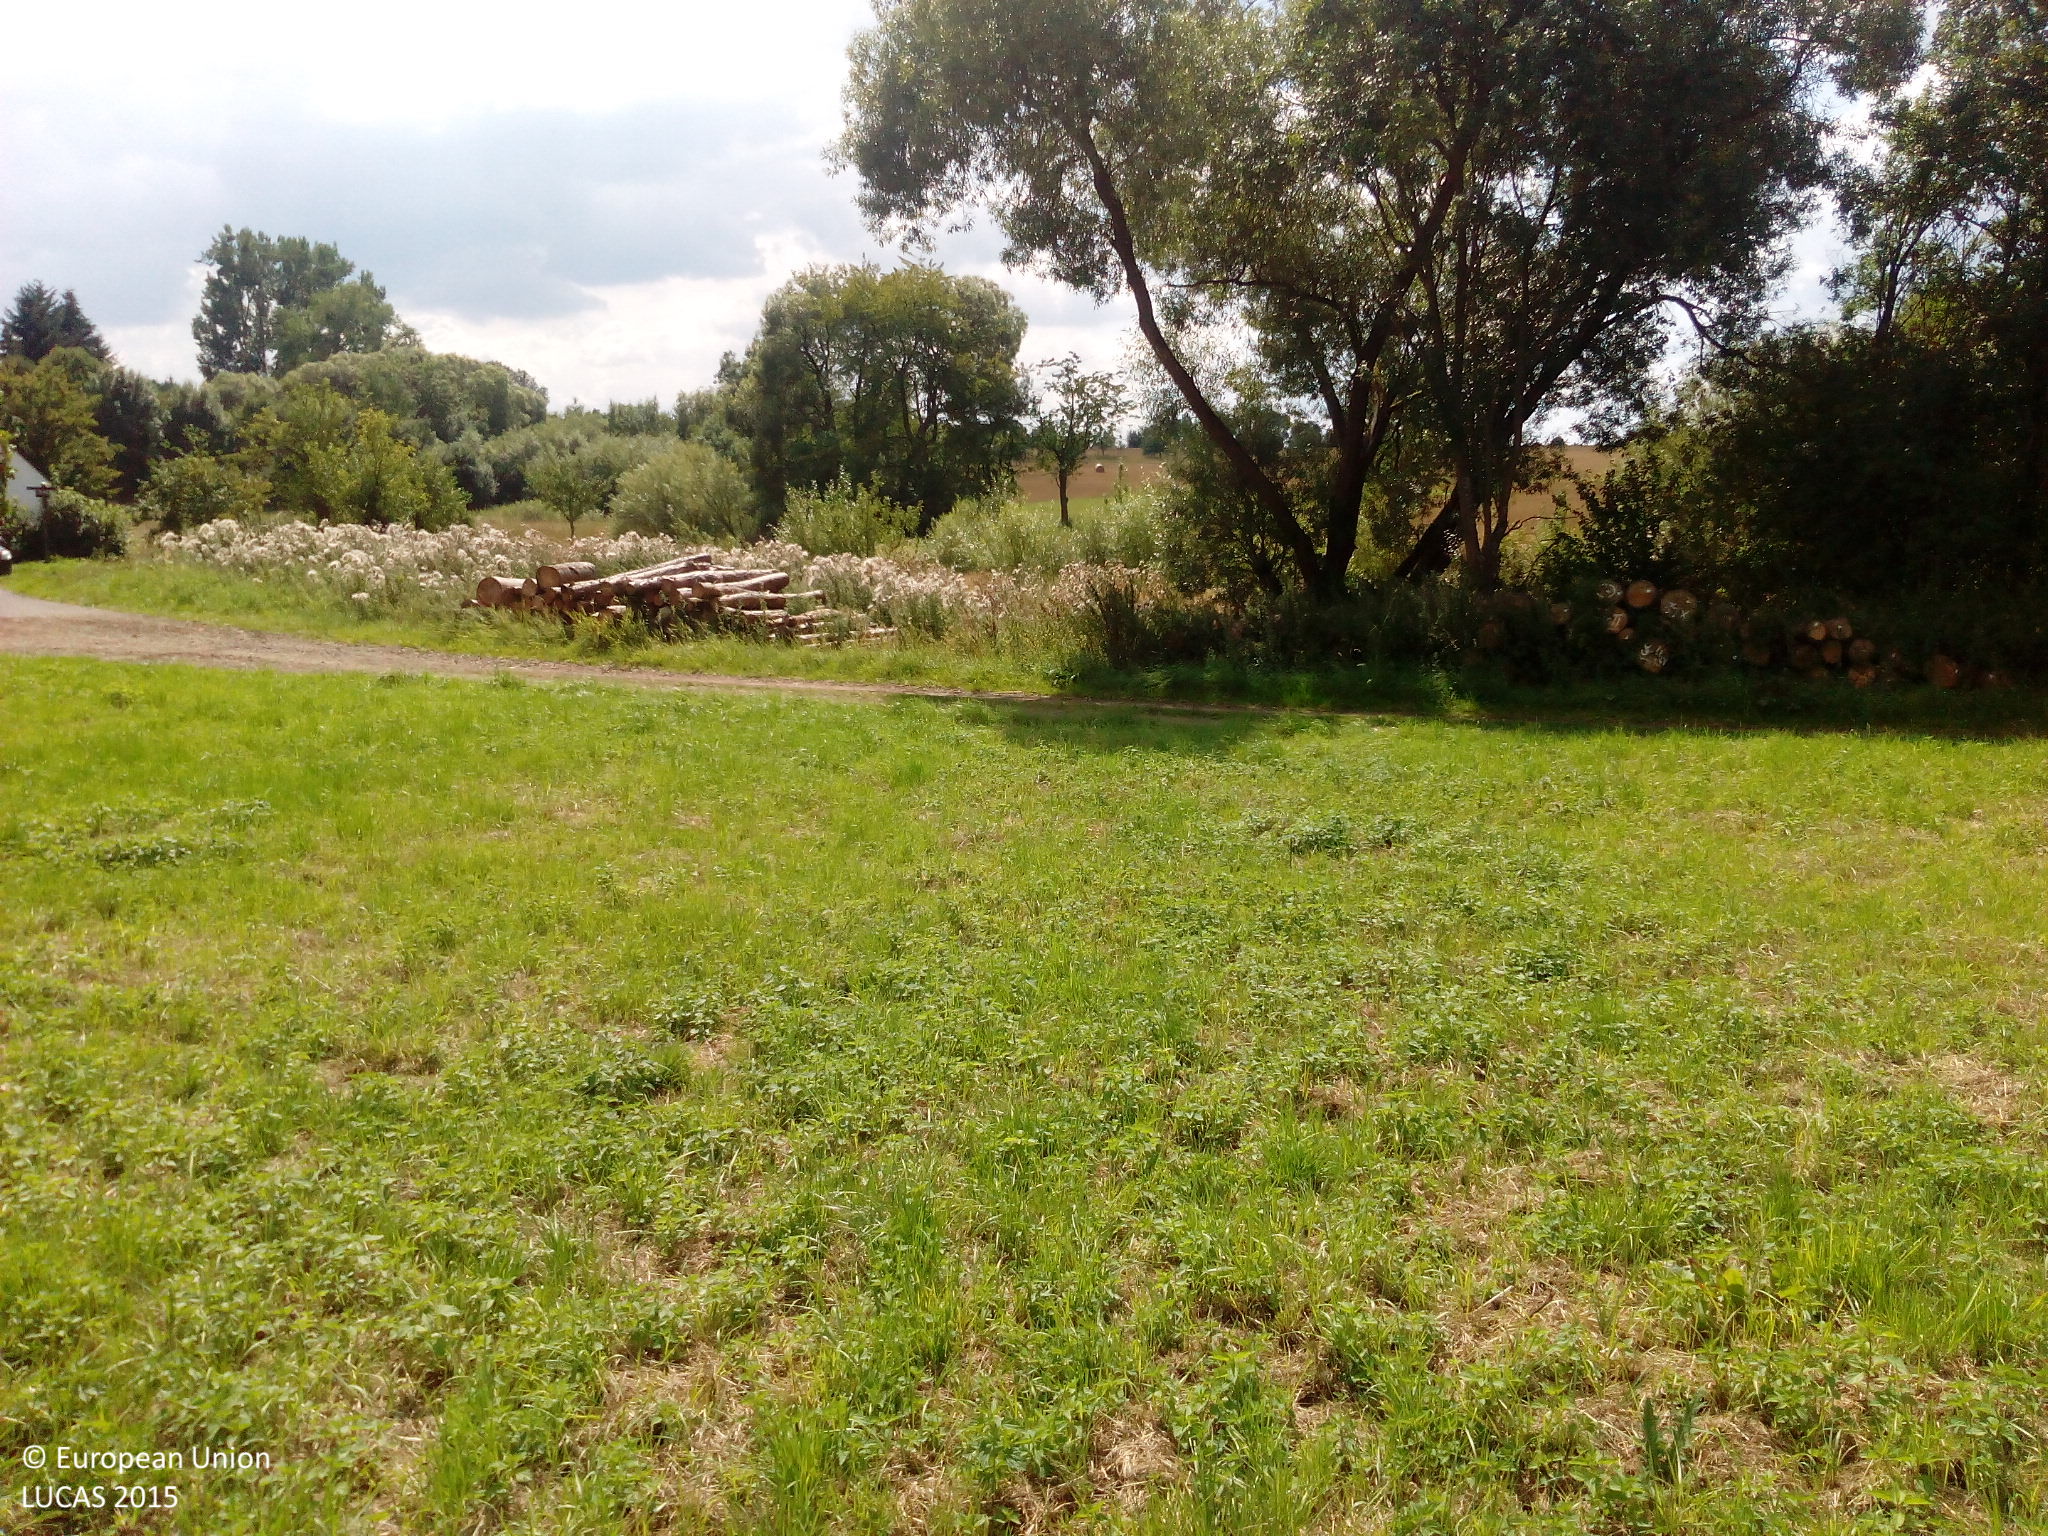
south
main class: Grassland
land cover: Grassland without tree/shrub cover
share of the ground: > 75 %
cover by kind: herbaceous plants 80 %, unconsolidated bare surface 20 %
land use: Agriculture (excluding fallow land and kitchen gardens)
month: August
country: DE
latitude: 50.2107
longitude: 7.4920
